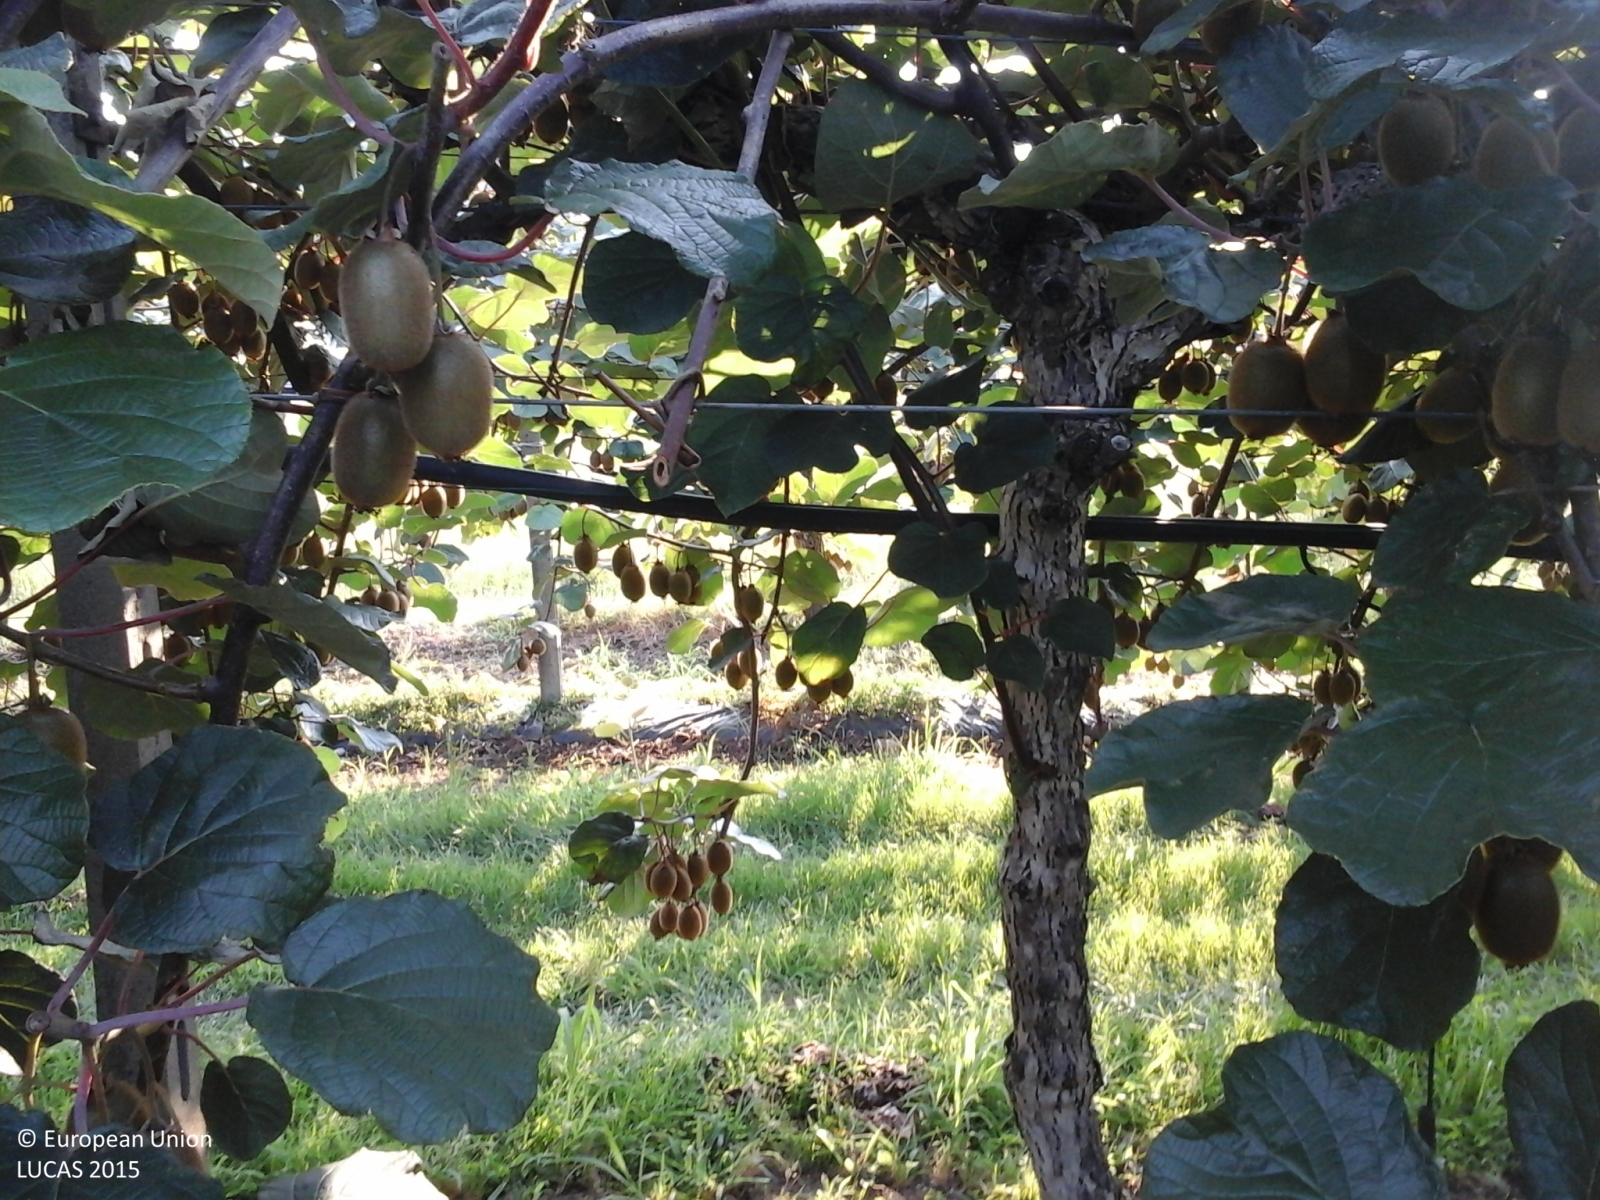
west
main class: Cropland
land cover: Other fruit trees and berries
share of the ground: > 75 %
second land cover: Grassland without tree/shrub cover
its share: > 75 %
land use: Agriculture (excluding fallow land and kitchen gardens)
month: July
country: IT
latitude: 45.3741
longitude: 10.9305
